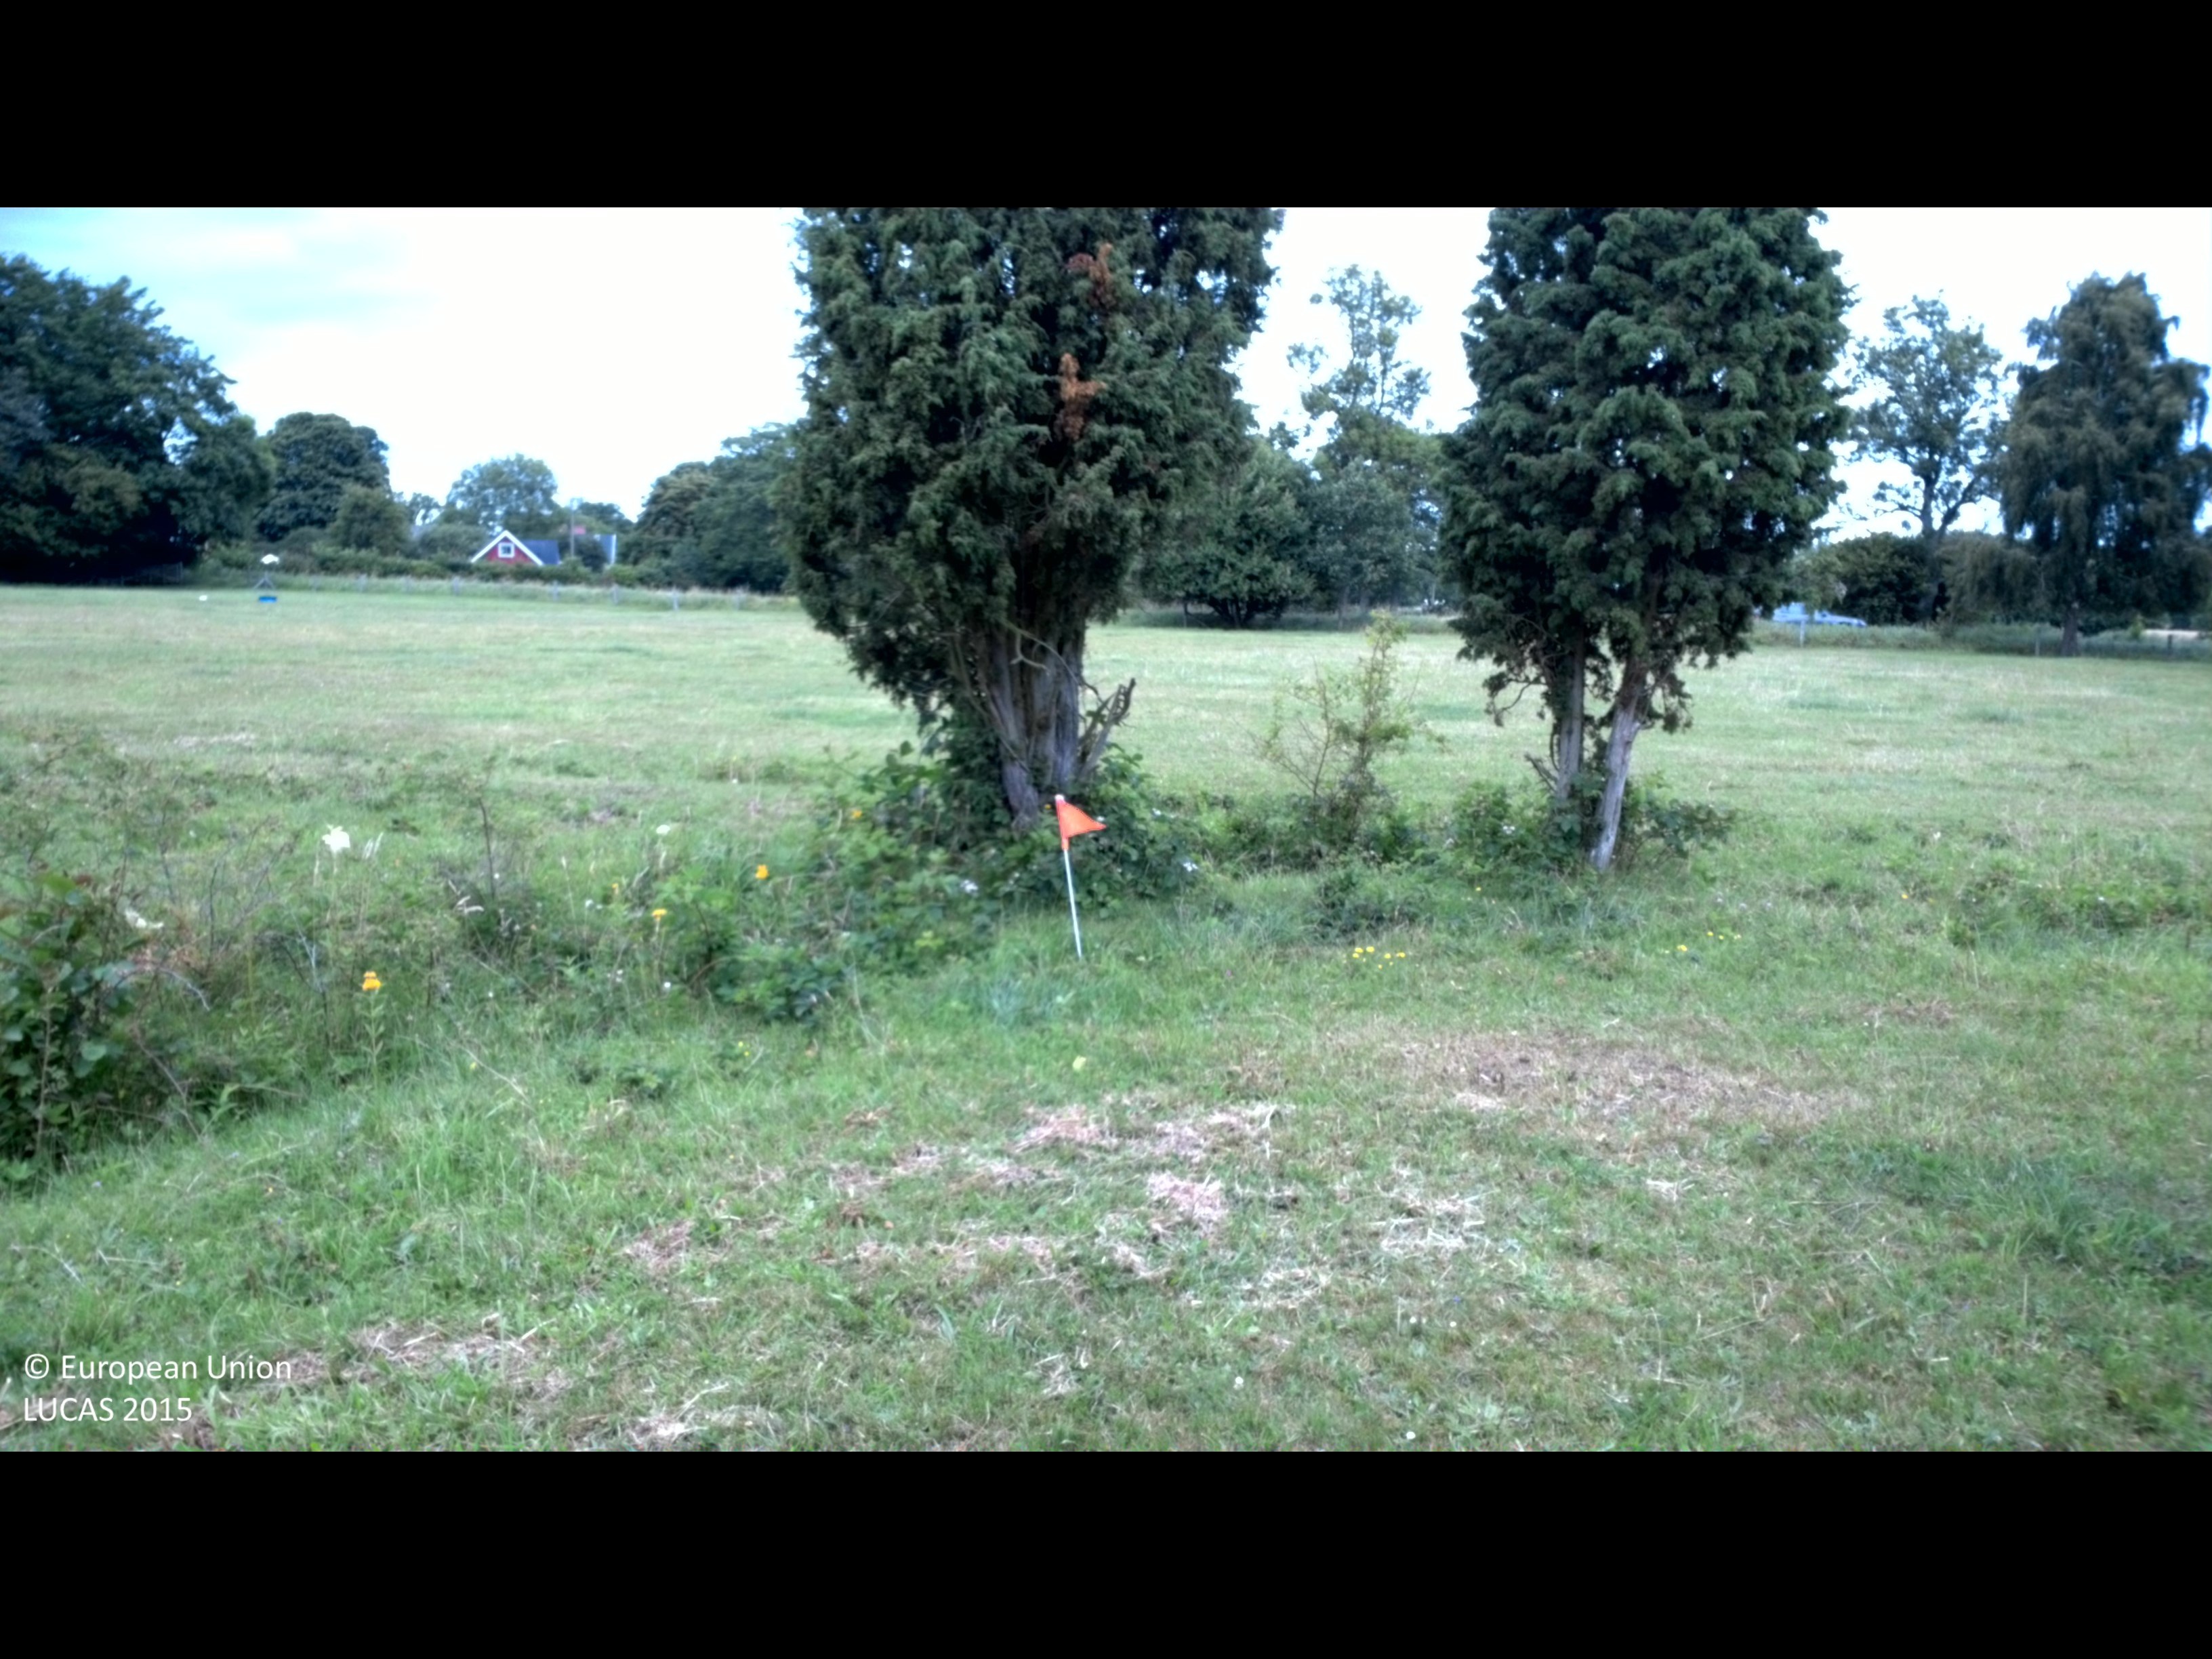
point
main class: Grassland
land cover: Grassland without tree/shrub cover
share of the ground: > 75 %
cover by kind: herbaceous plants 95 %, shrubs 5 %
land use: Agriculture (excluding fallow land and kitchen gardens)
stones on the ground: < 10 %
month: July
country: SE
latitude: 57.1864
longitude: 17.0338
